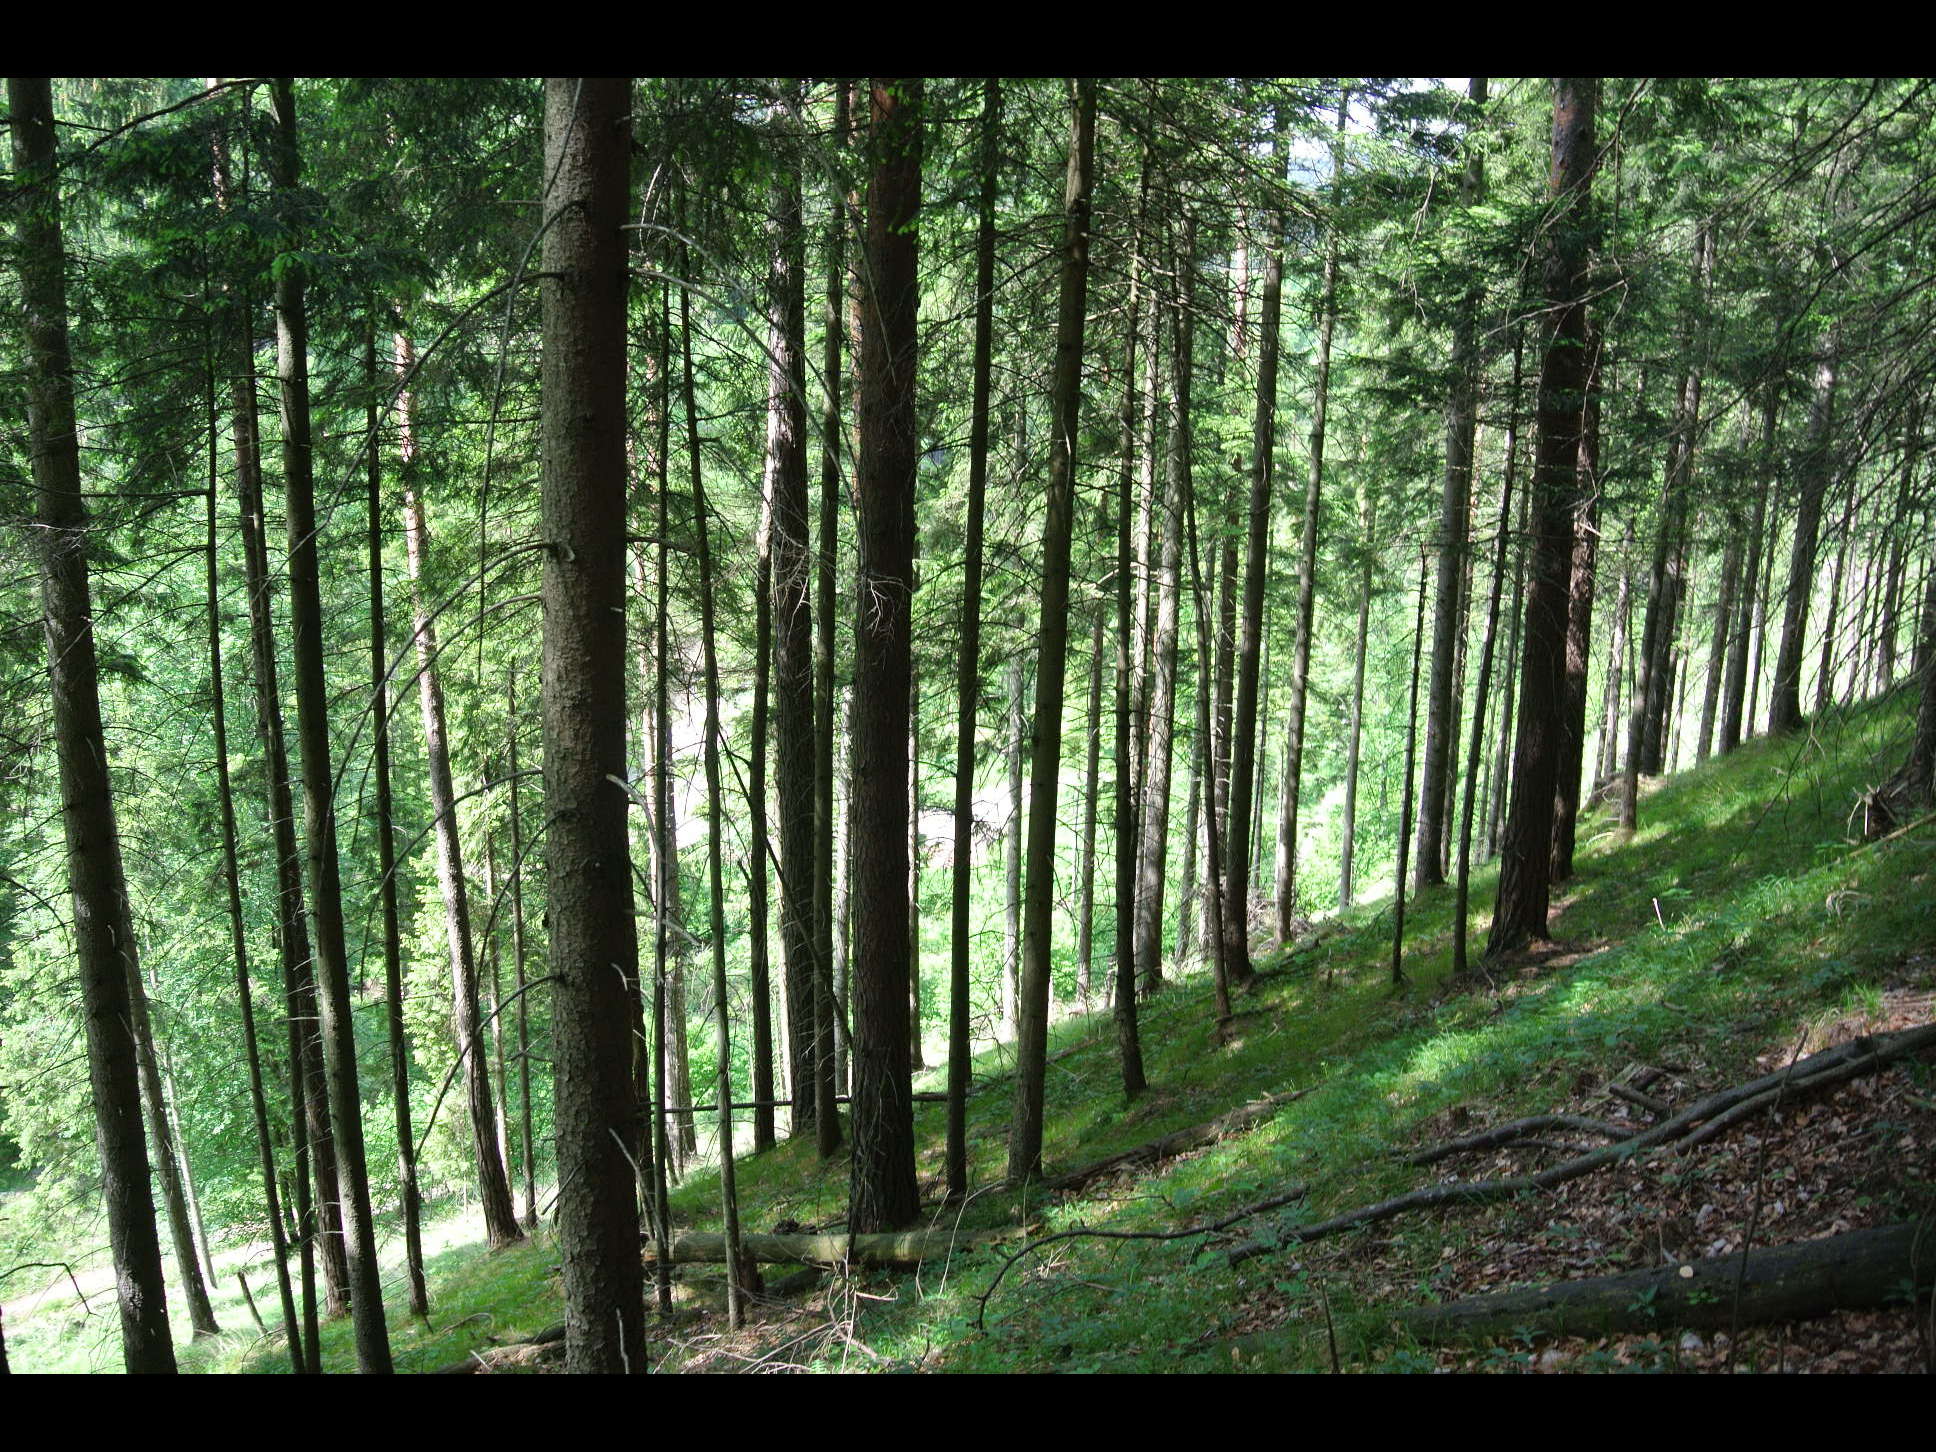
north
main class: Woodland
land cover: Spruce dominated mixed woodland
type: alpine coniferous forest
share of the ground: > 75 %
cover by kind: coniferous forest trees 75 %, broadleaved forest trees 25 %
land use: Forestry
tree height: > 5 m
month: May
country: AT
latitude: 47.9460
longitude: 15.7731
